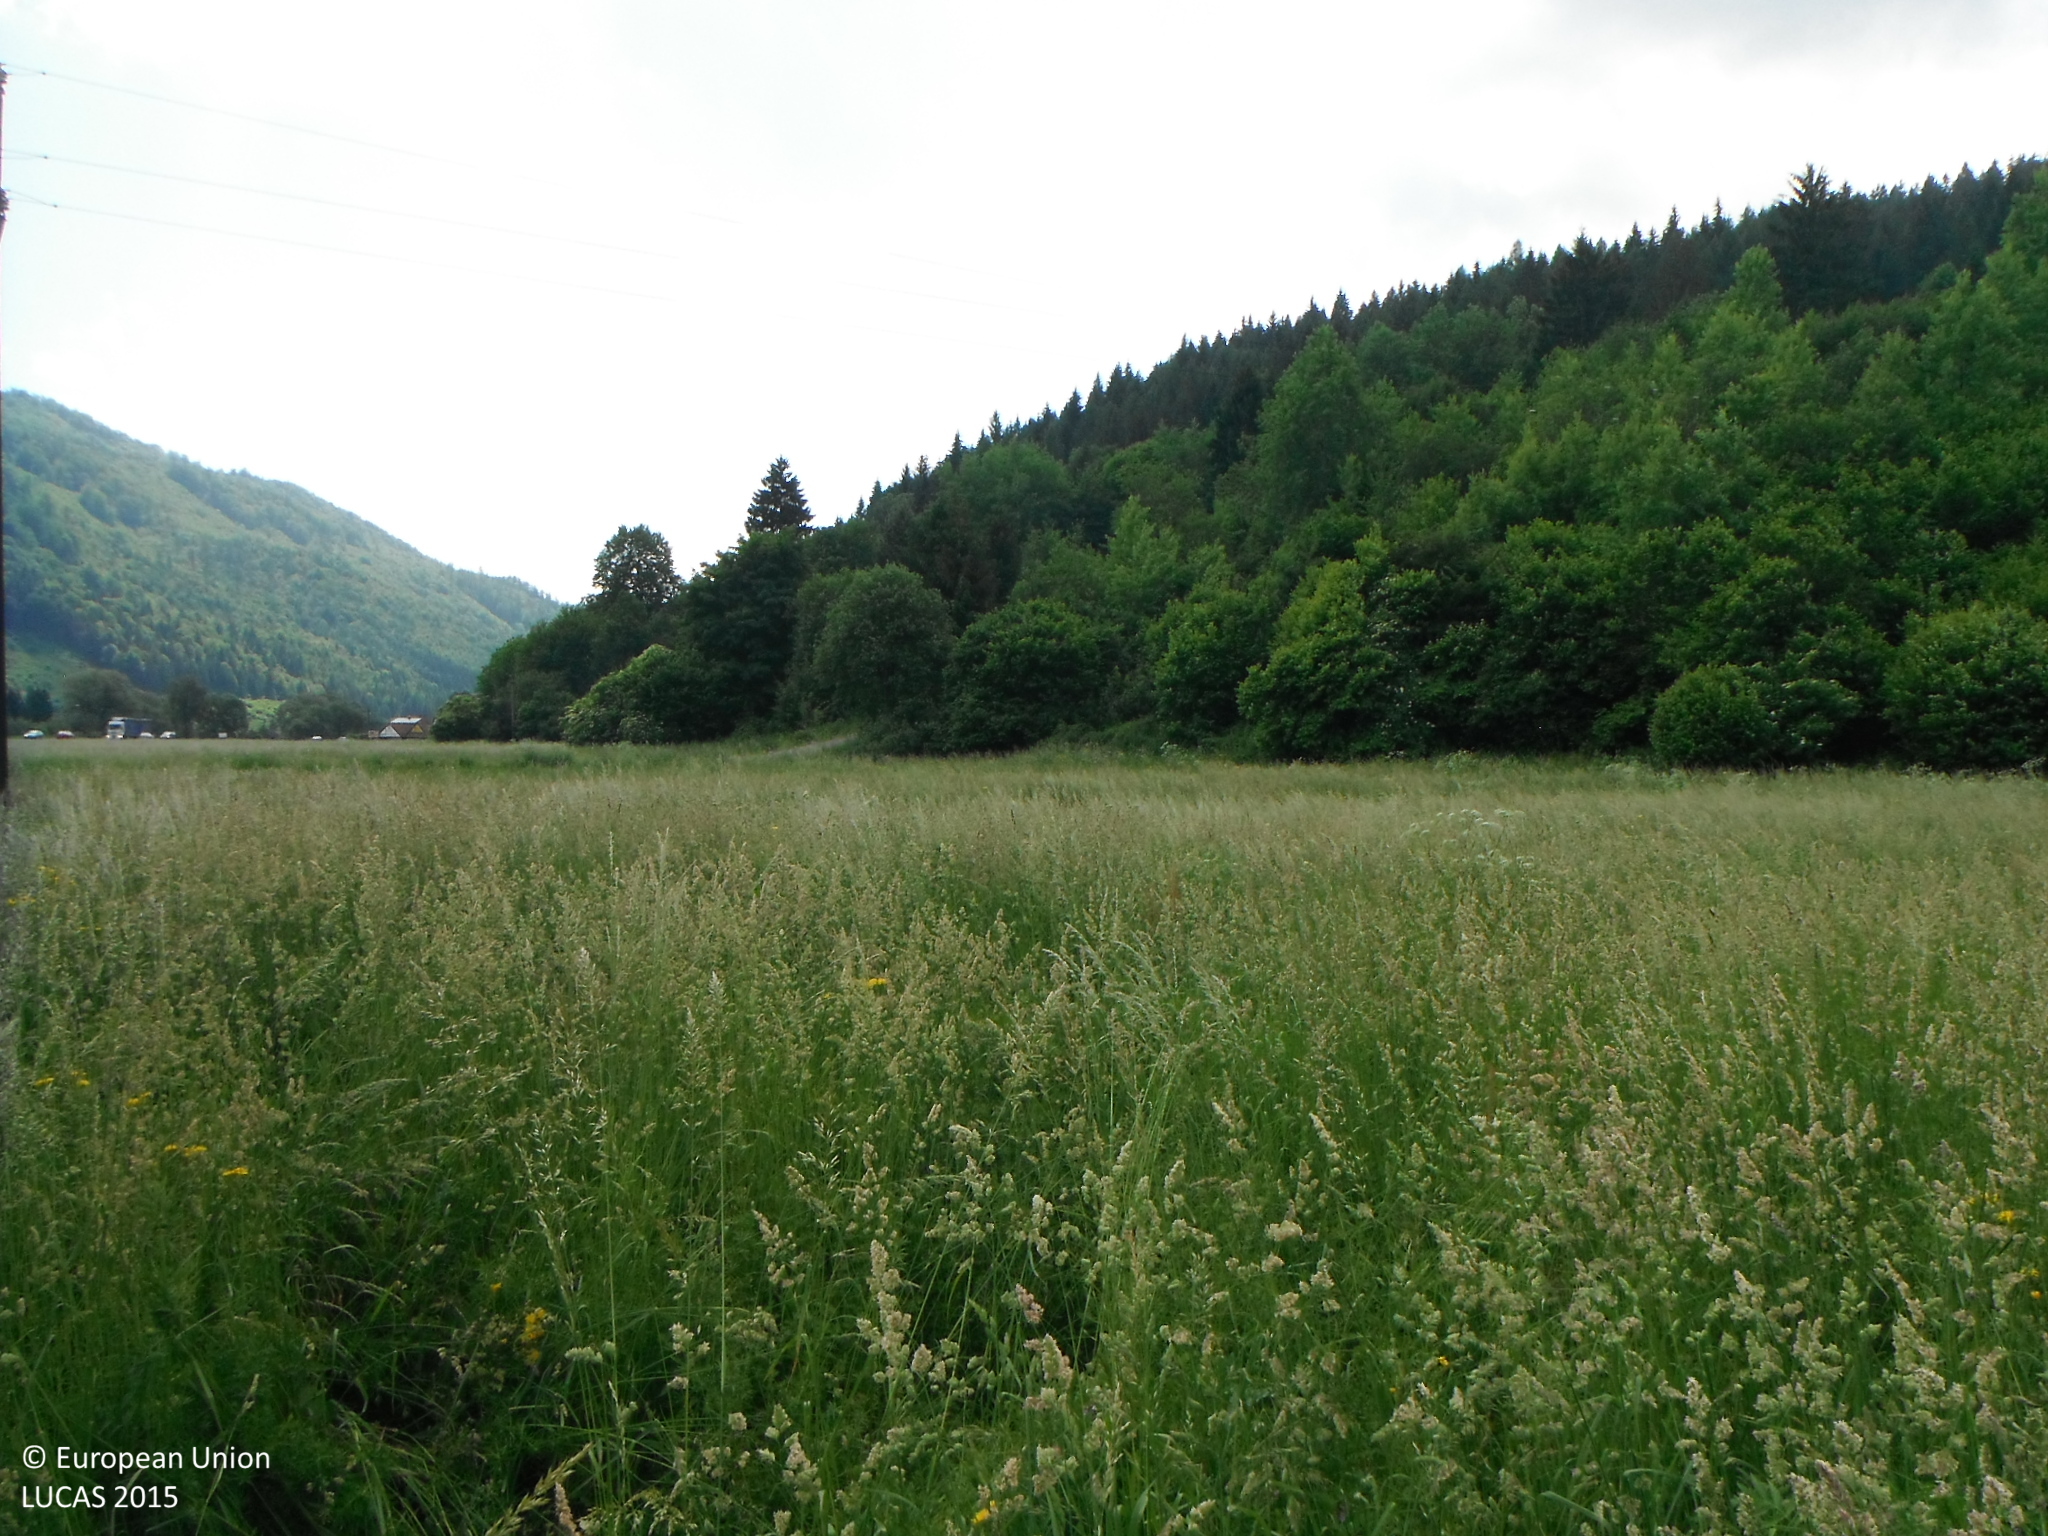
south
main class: Grassland
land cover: Grassland without tree/shrub cover
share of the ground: > 75 %
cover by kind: herbaceous plants 100 %
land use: Agriculture (excluding fallow land and kitchen gardens)
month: June
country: SK
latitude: 49.1445
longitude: 19.1669
